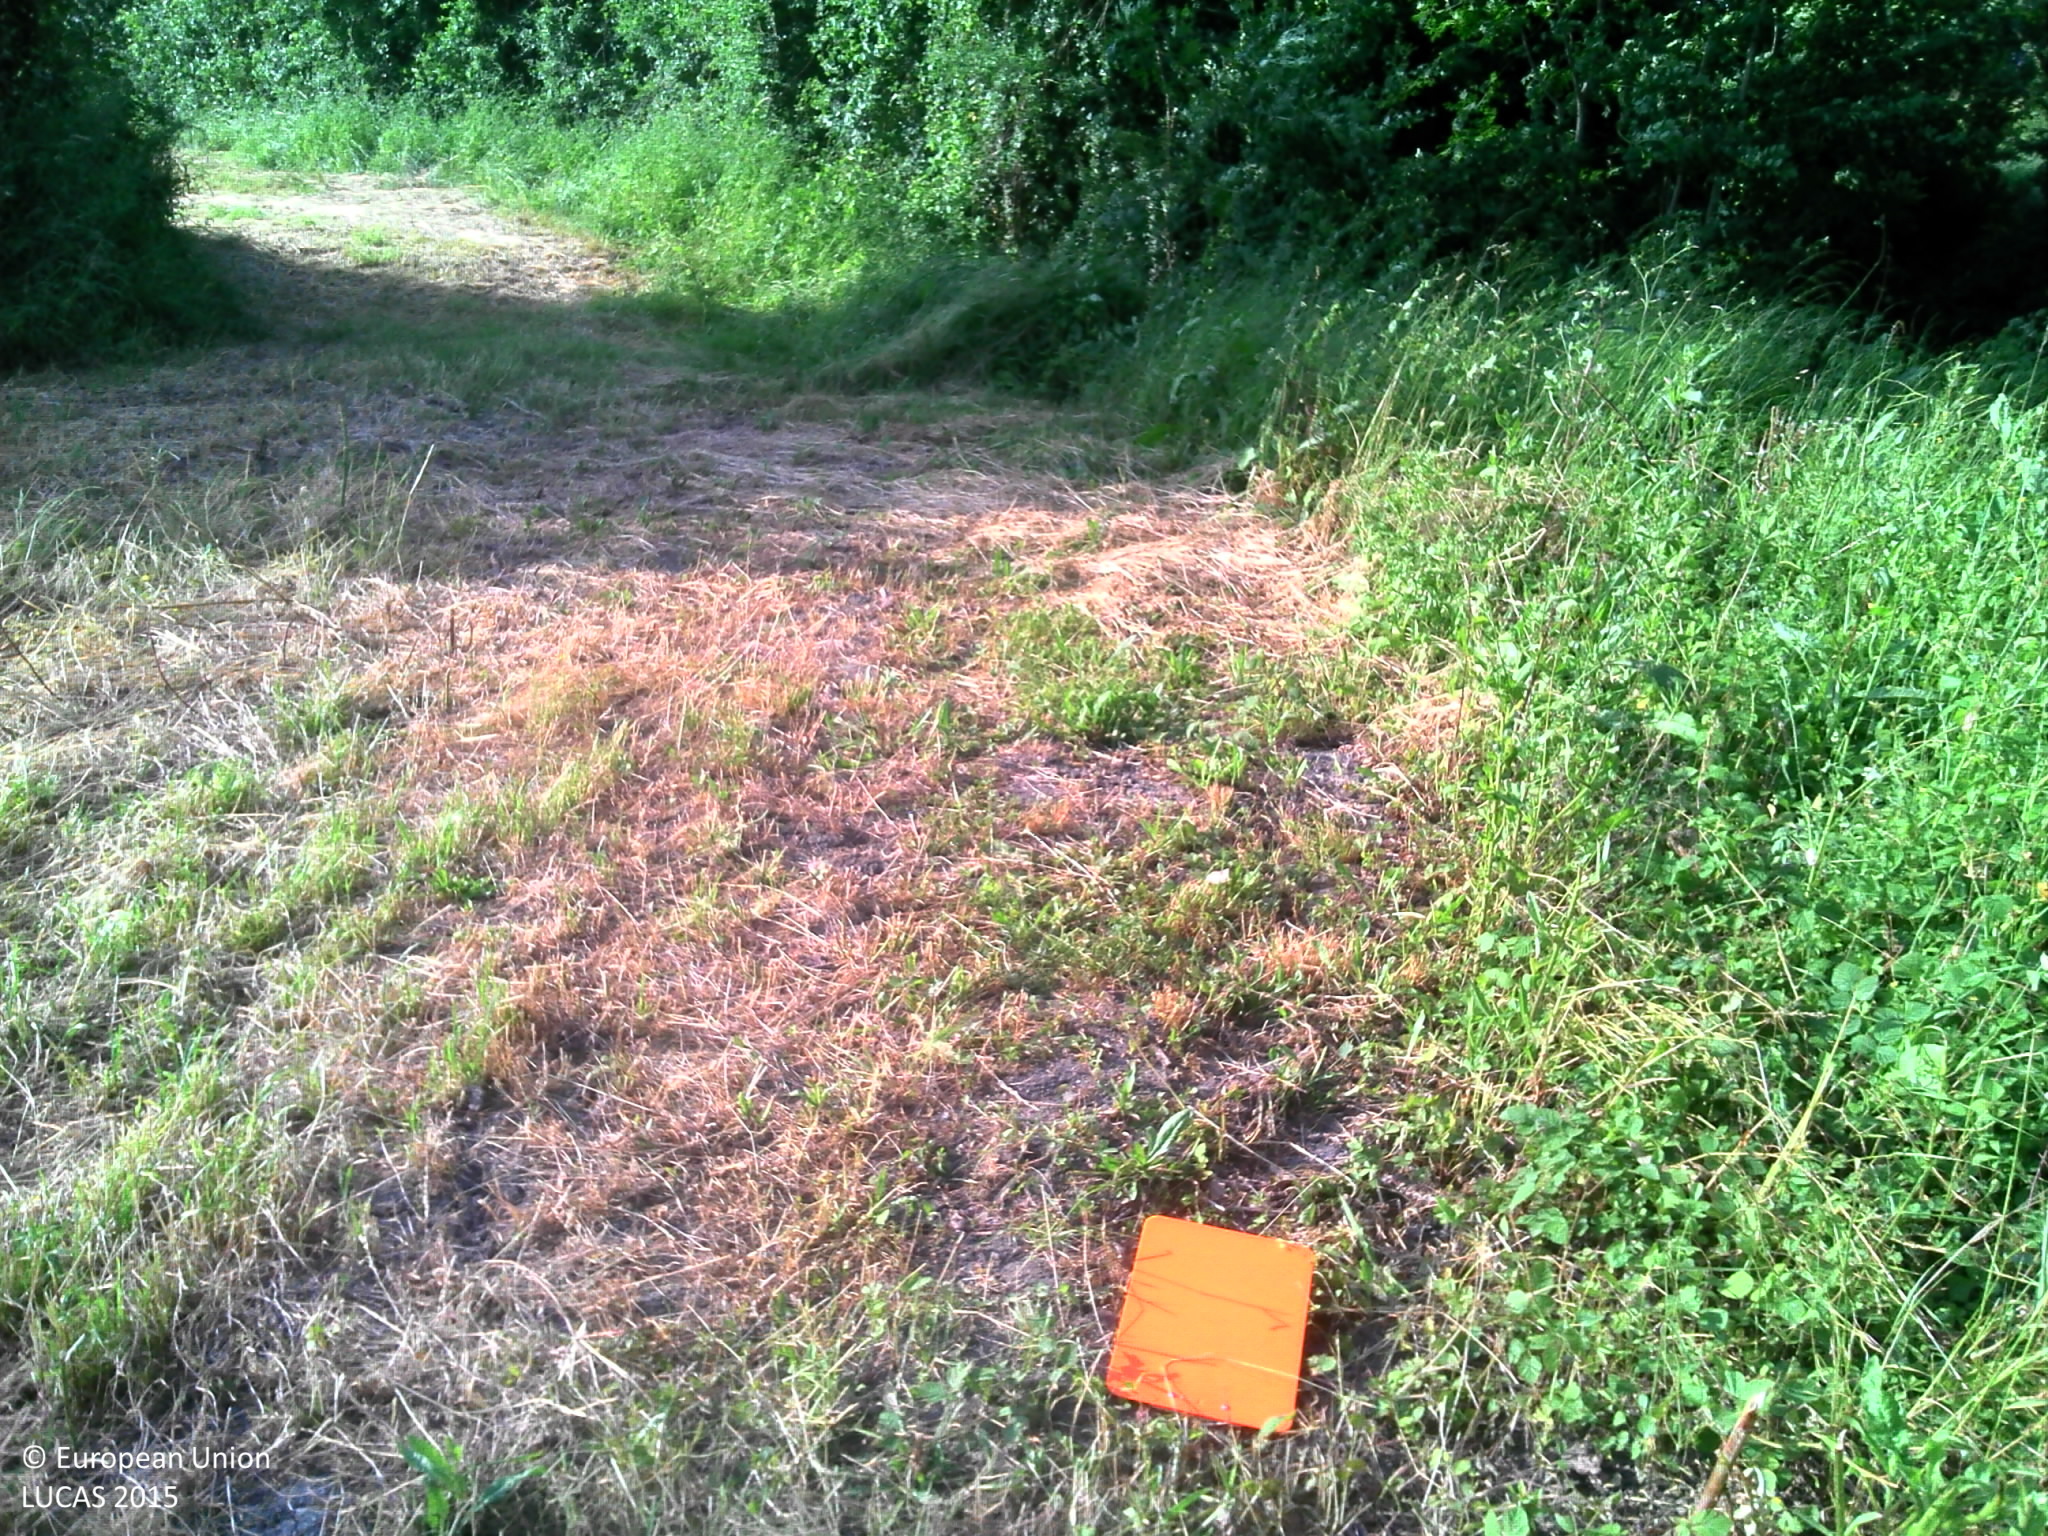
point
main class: Grassland
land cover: Grassland without tree/shrub cover
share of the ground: > 75 %
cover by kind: herbaceous plants 100 %
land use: Agriculture (excluding fallow land and kitchen gardens)
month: June
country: FR
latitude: 46.0418
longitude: -0.9482
